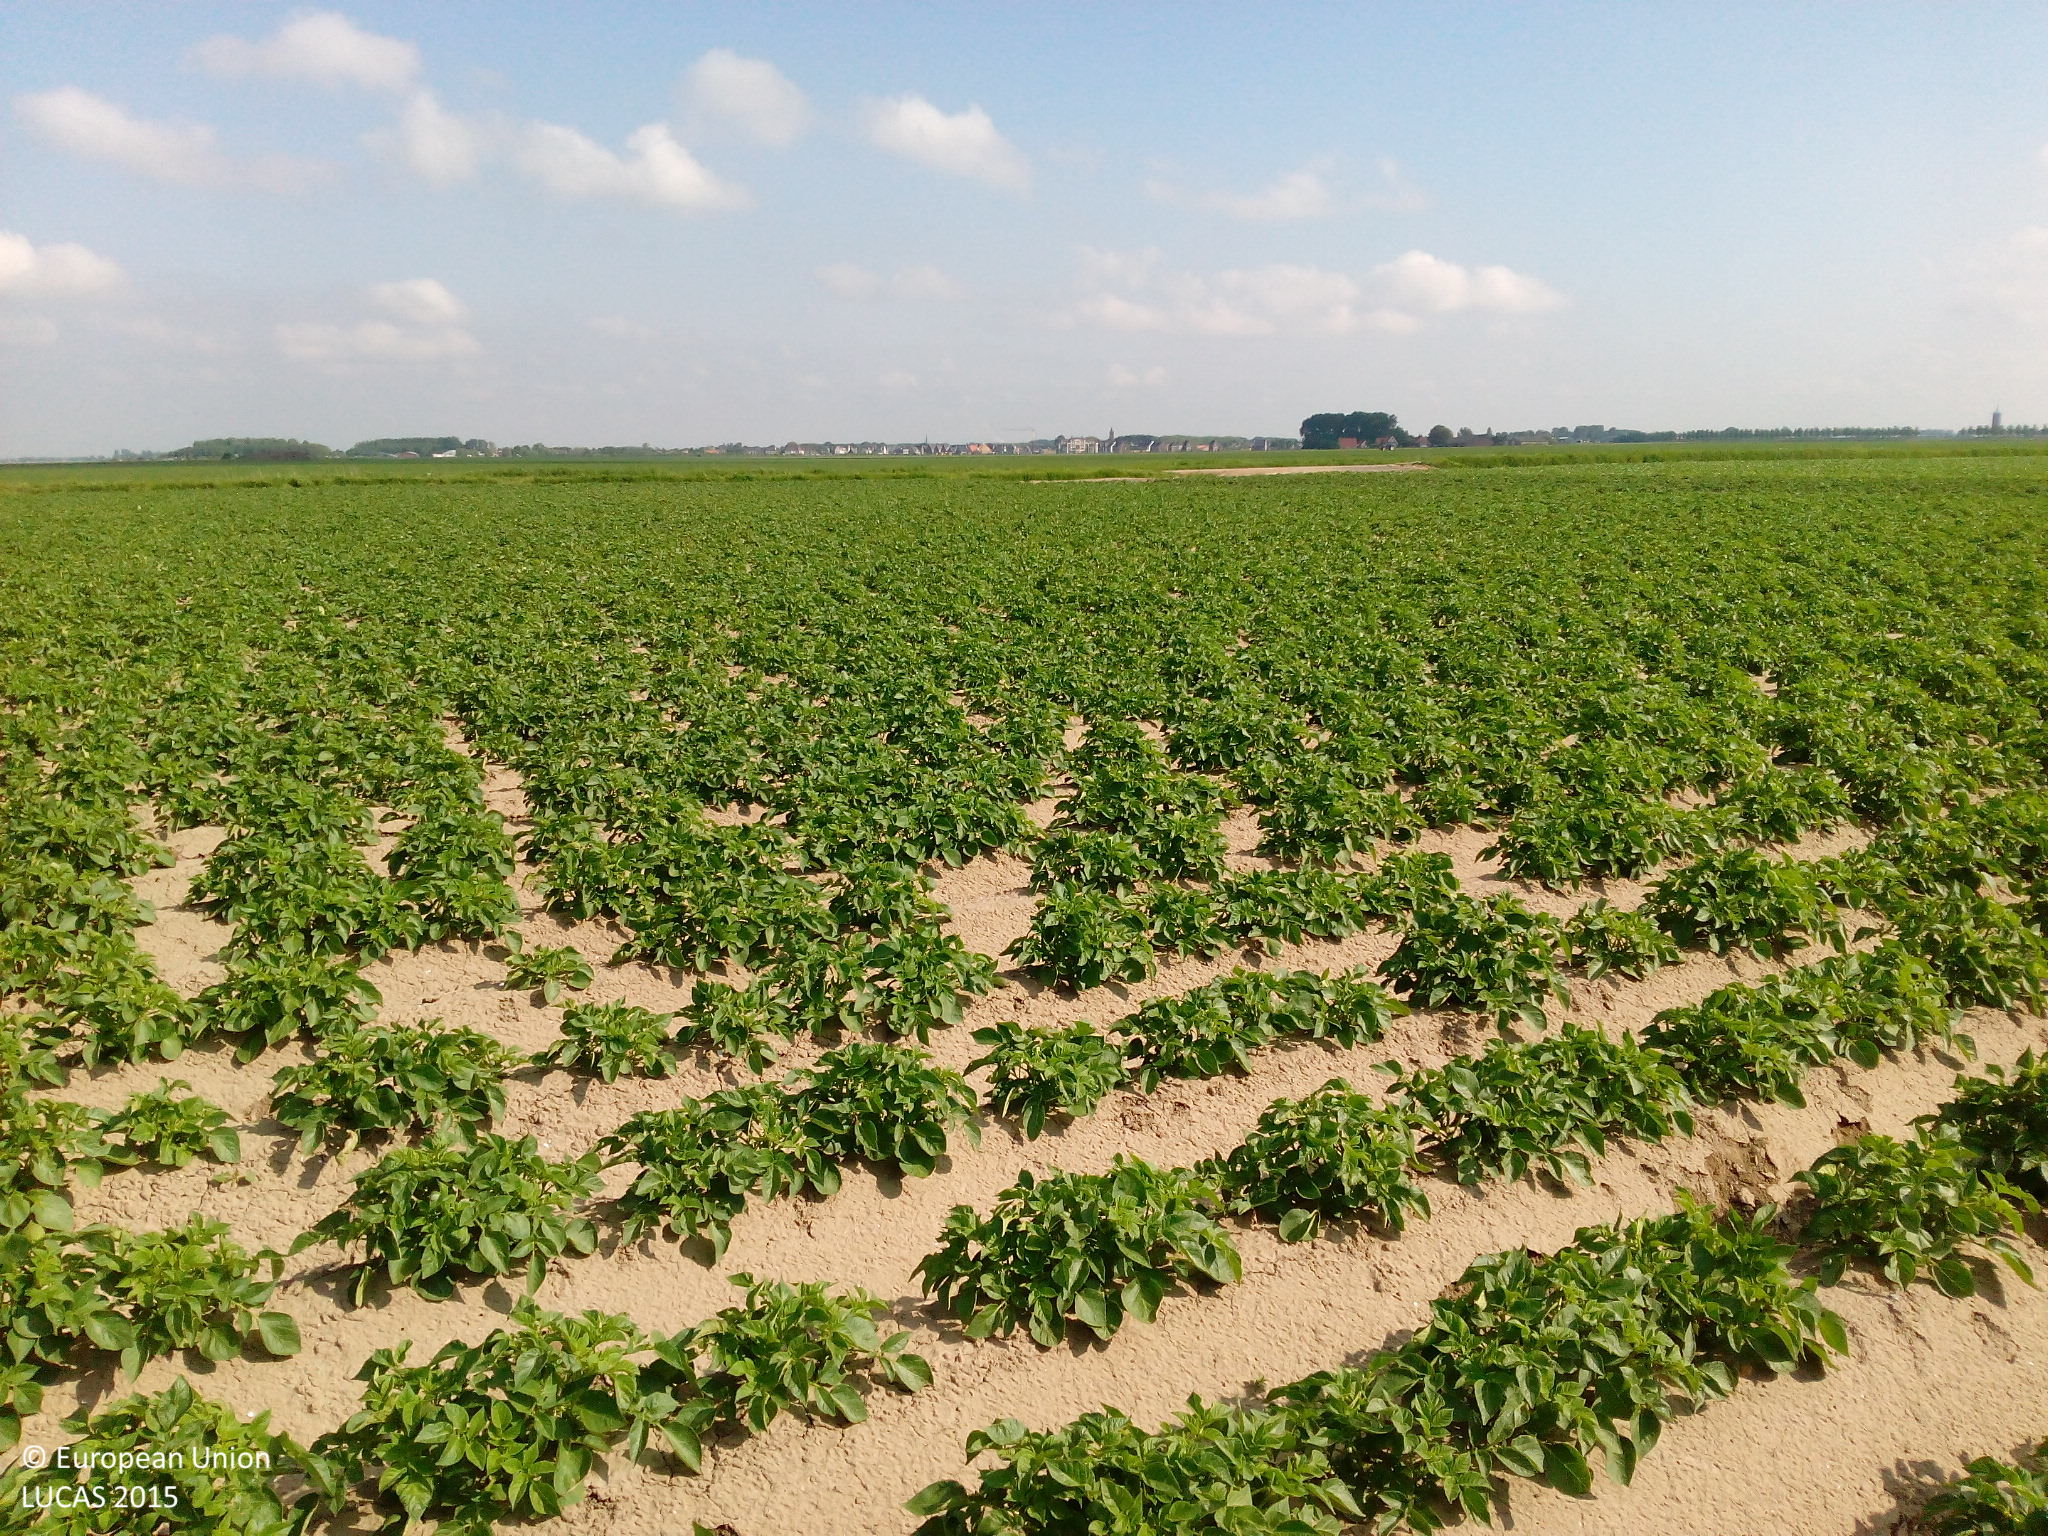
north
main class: Cropland
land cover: Potatoes
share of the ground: 50 - 75 %
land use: Agriculture (excluding fallow land and kitchen gardens)
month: June
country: NL
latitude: 51.7262
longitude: 4.1022
